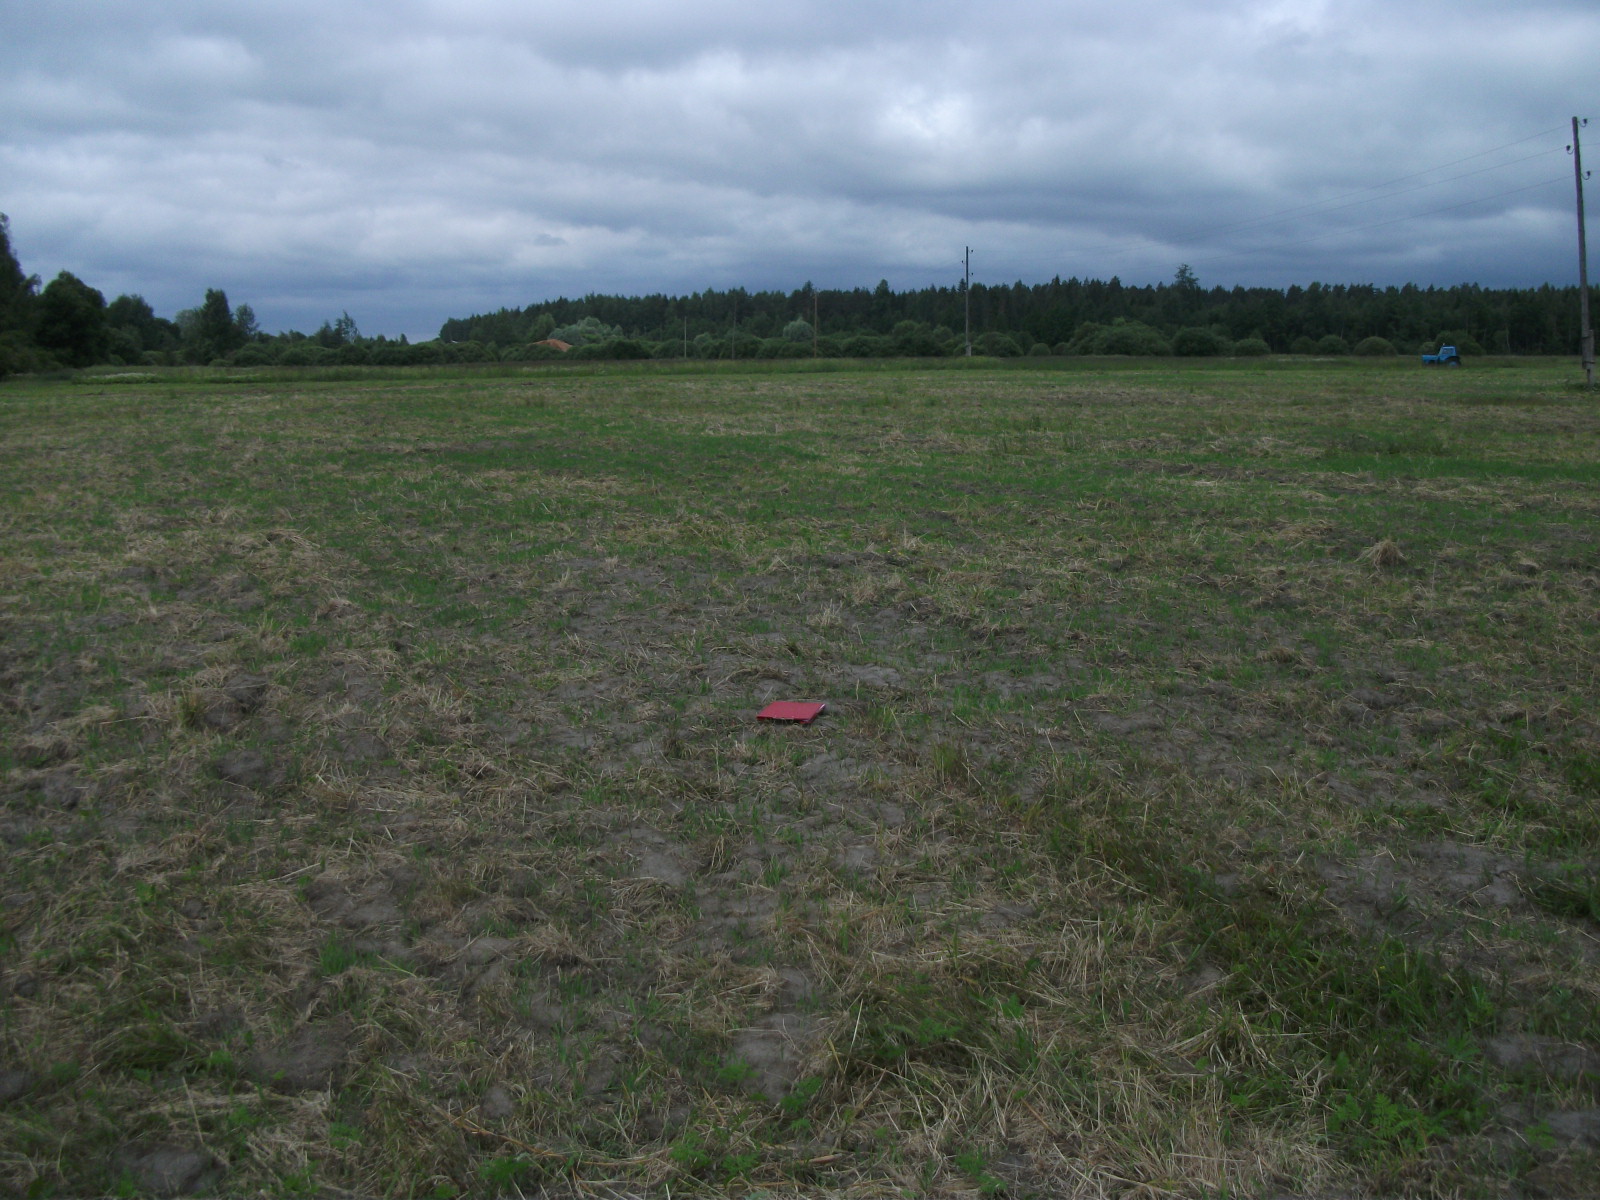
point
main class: Grassland
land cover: Grassland without tree/shrub cover
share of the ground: 50 - 75 %
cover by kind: herbaceous plants 70 %, unconsolidated bare surface 30 %
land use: Agriculture (excluding fallow land and kitchen gardens)
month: January
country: LV
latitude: 56.8890
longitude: 26.6800
